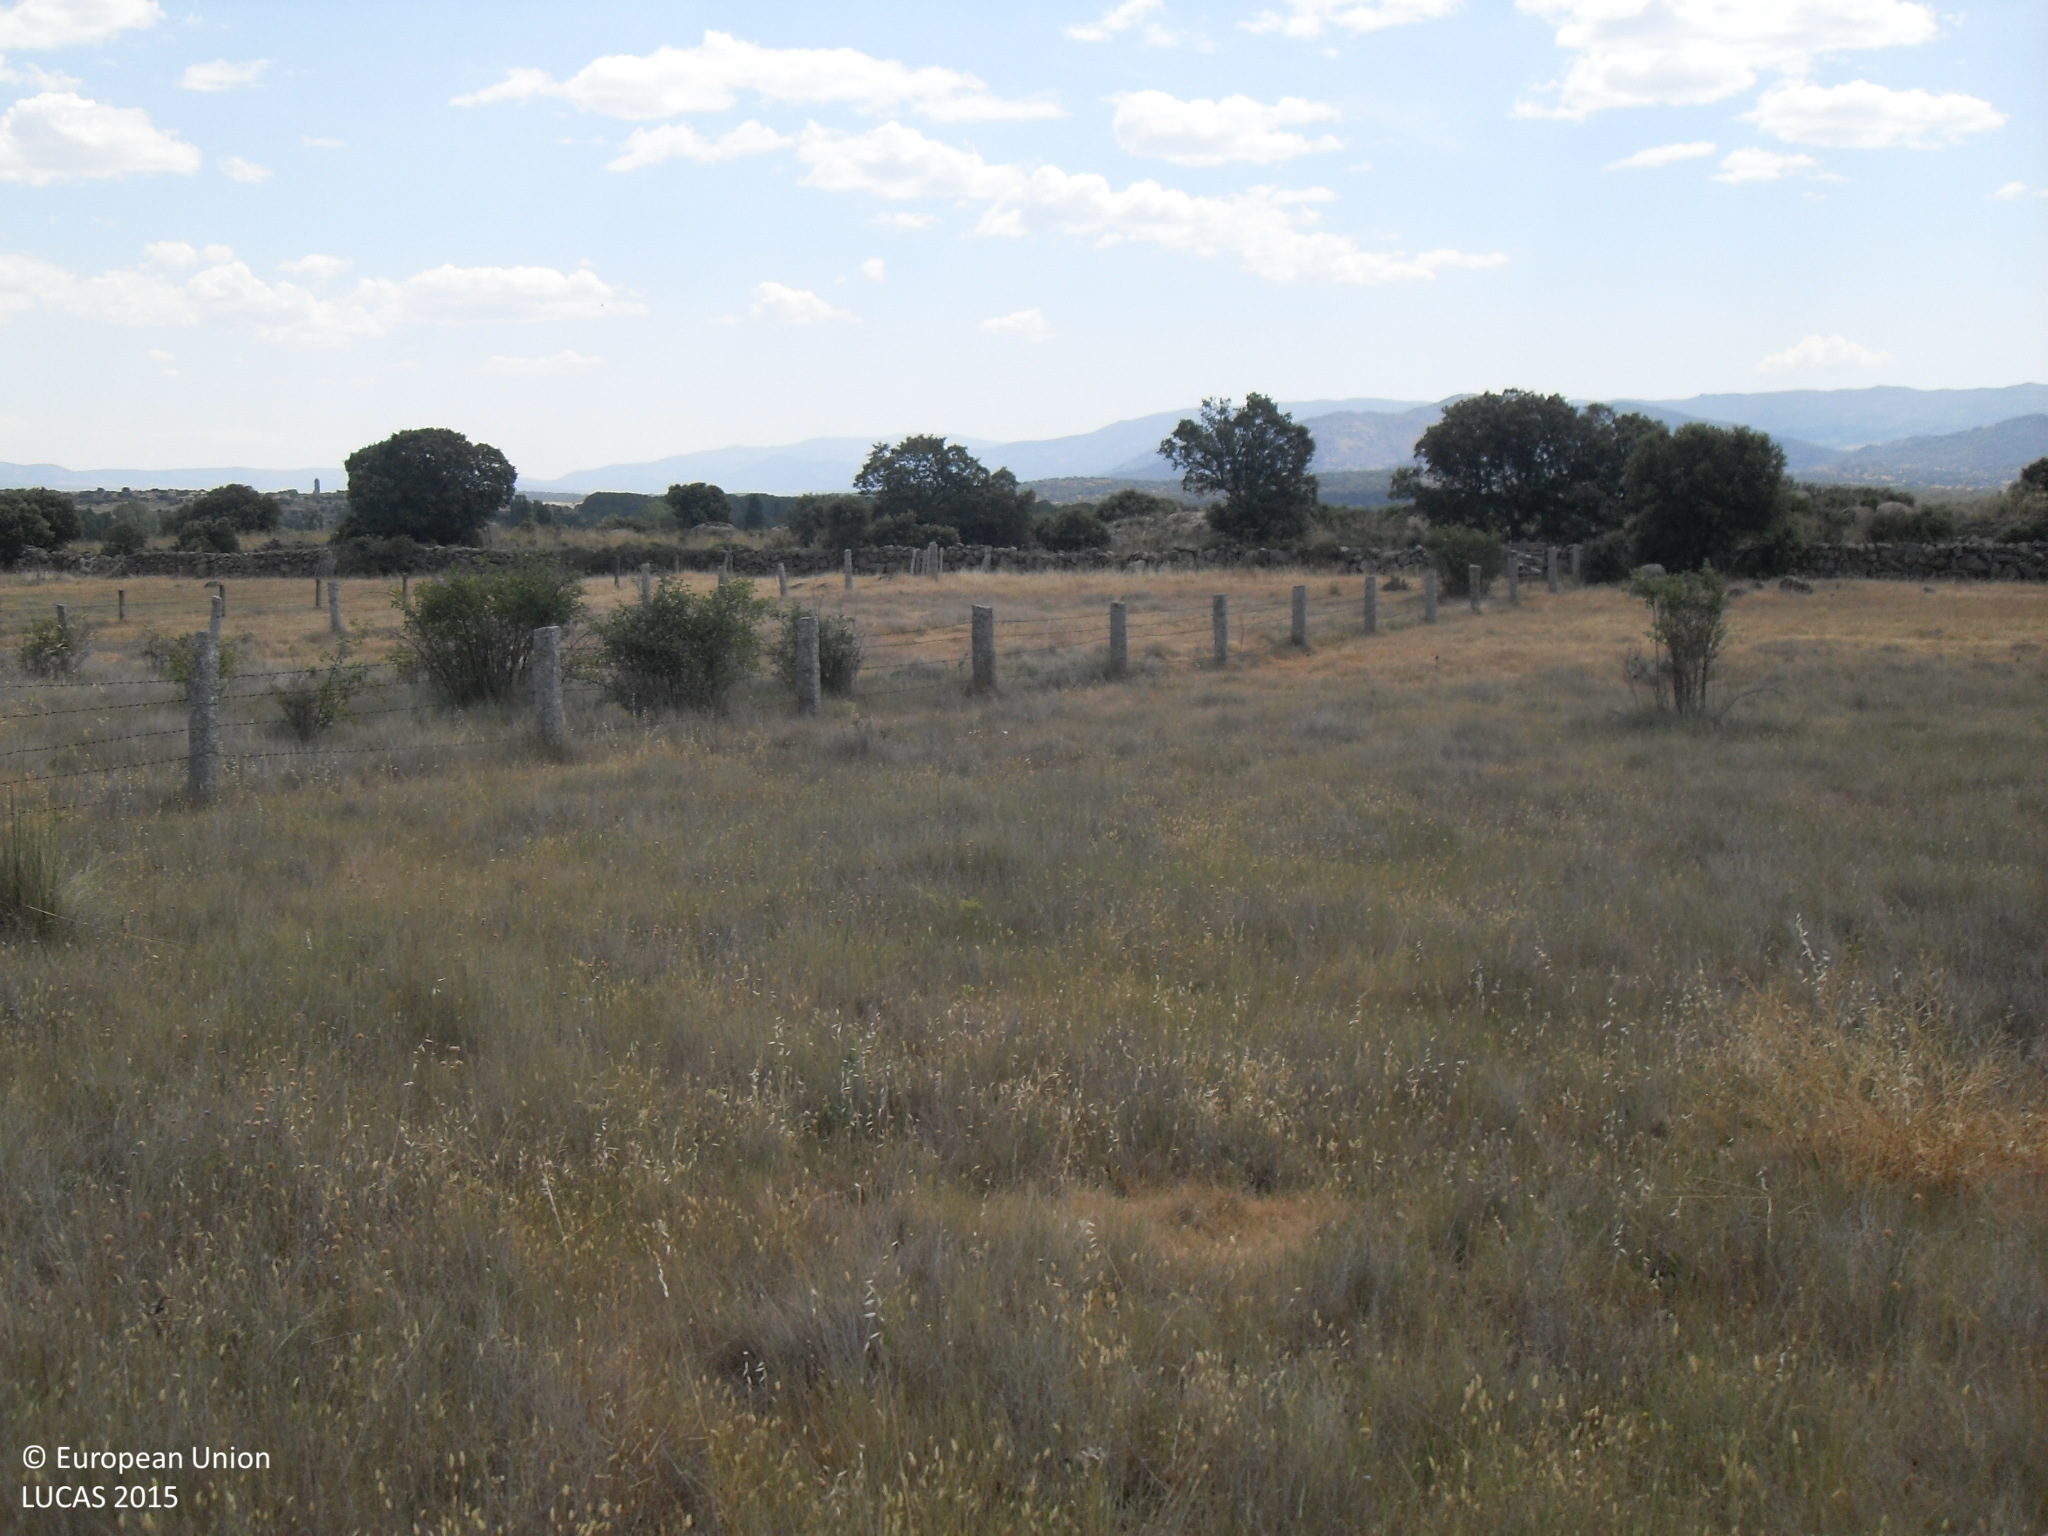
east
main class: Grassland
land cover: Grassland without tree/shrub cover
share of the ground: > 75 %
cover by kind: herbaceous plants 100 %
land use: Agriculture (excluding fallow land and kitchen gardens)
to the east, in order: Grassland without tree/shrub cover; Fences; Grassland without tree/shrub cover; Dry stone walls; Tracks; Dry stone walls; Grassland with sparse tree/shrub cover; Rocks and stones; Grassland with sparse tree/shrub cover
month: June
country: ES
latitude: 40.4565
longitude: -5.5267
